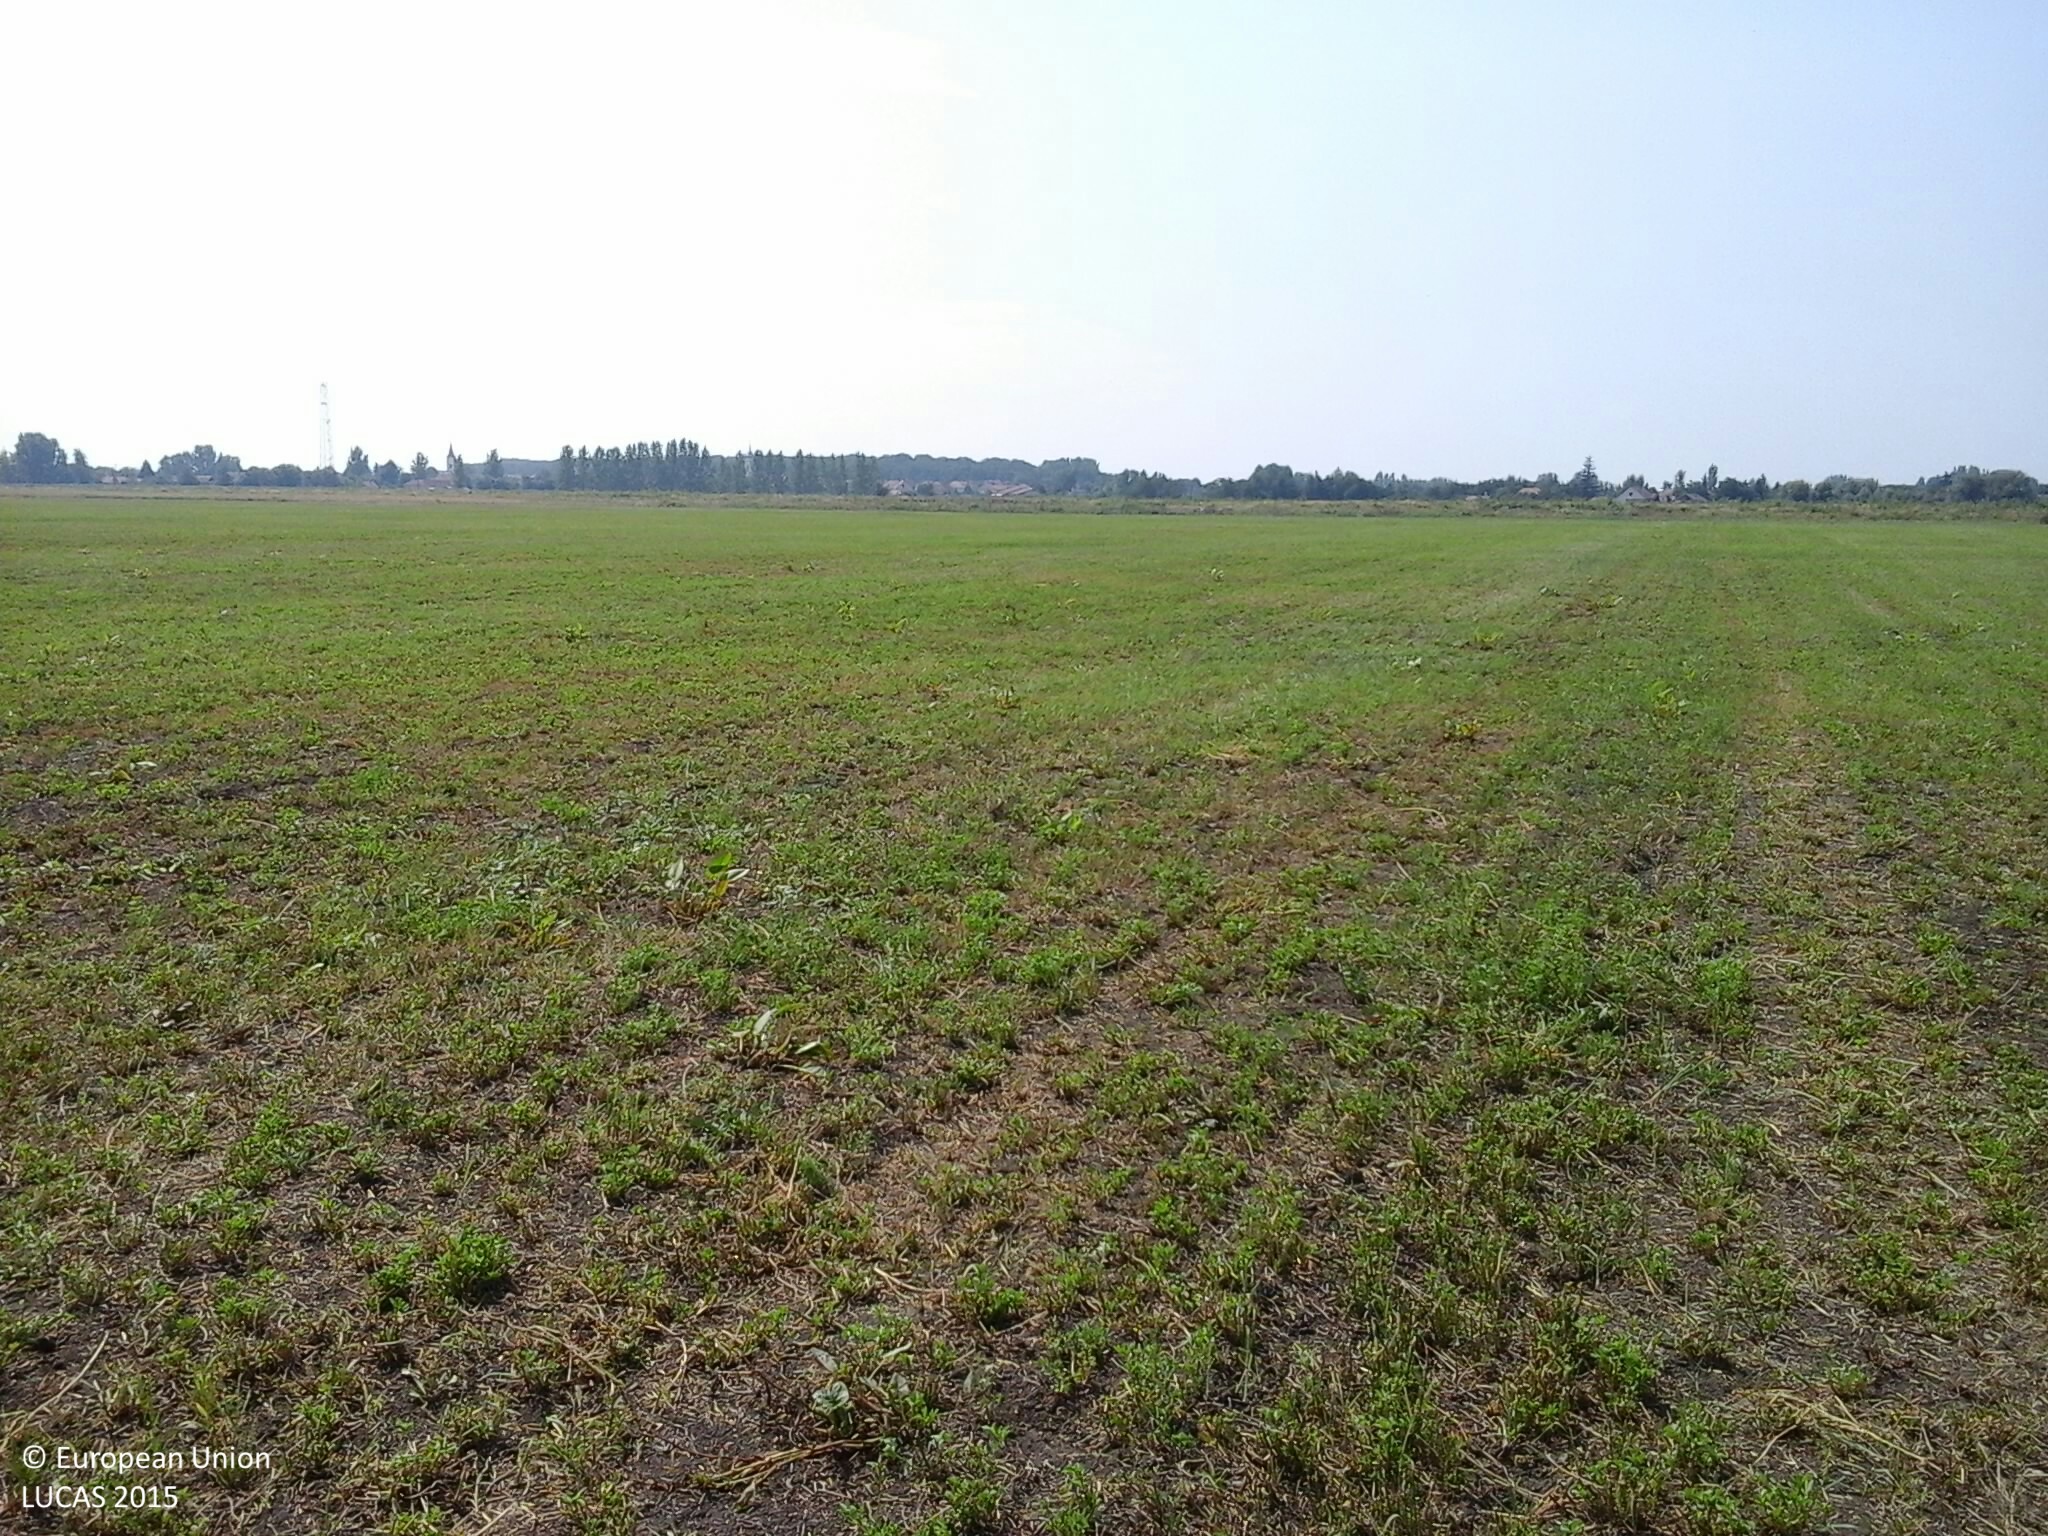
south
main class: Cropland
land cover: Lucerne
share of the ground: 50 - 75 %
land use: Agriculture (excluding fallow land and kitchen gardens)
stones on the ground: < 10 %
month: August
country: HU
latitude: 47.7096
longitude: 20.9798
